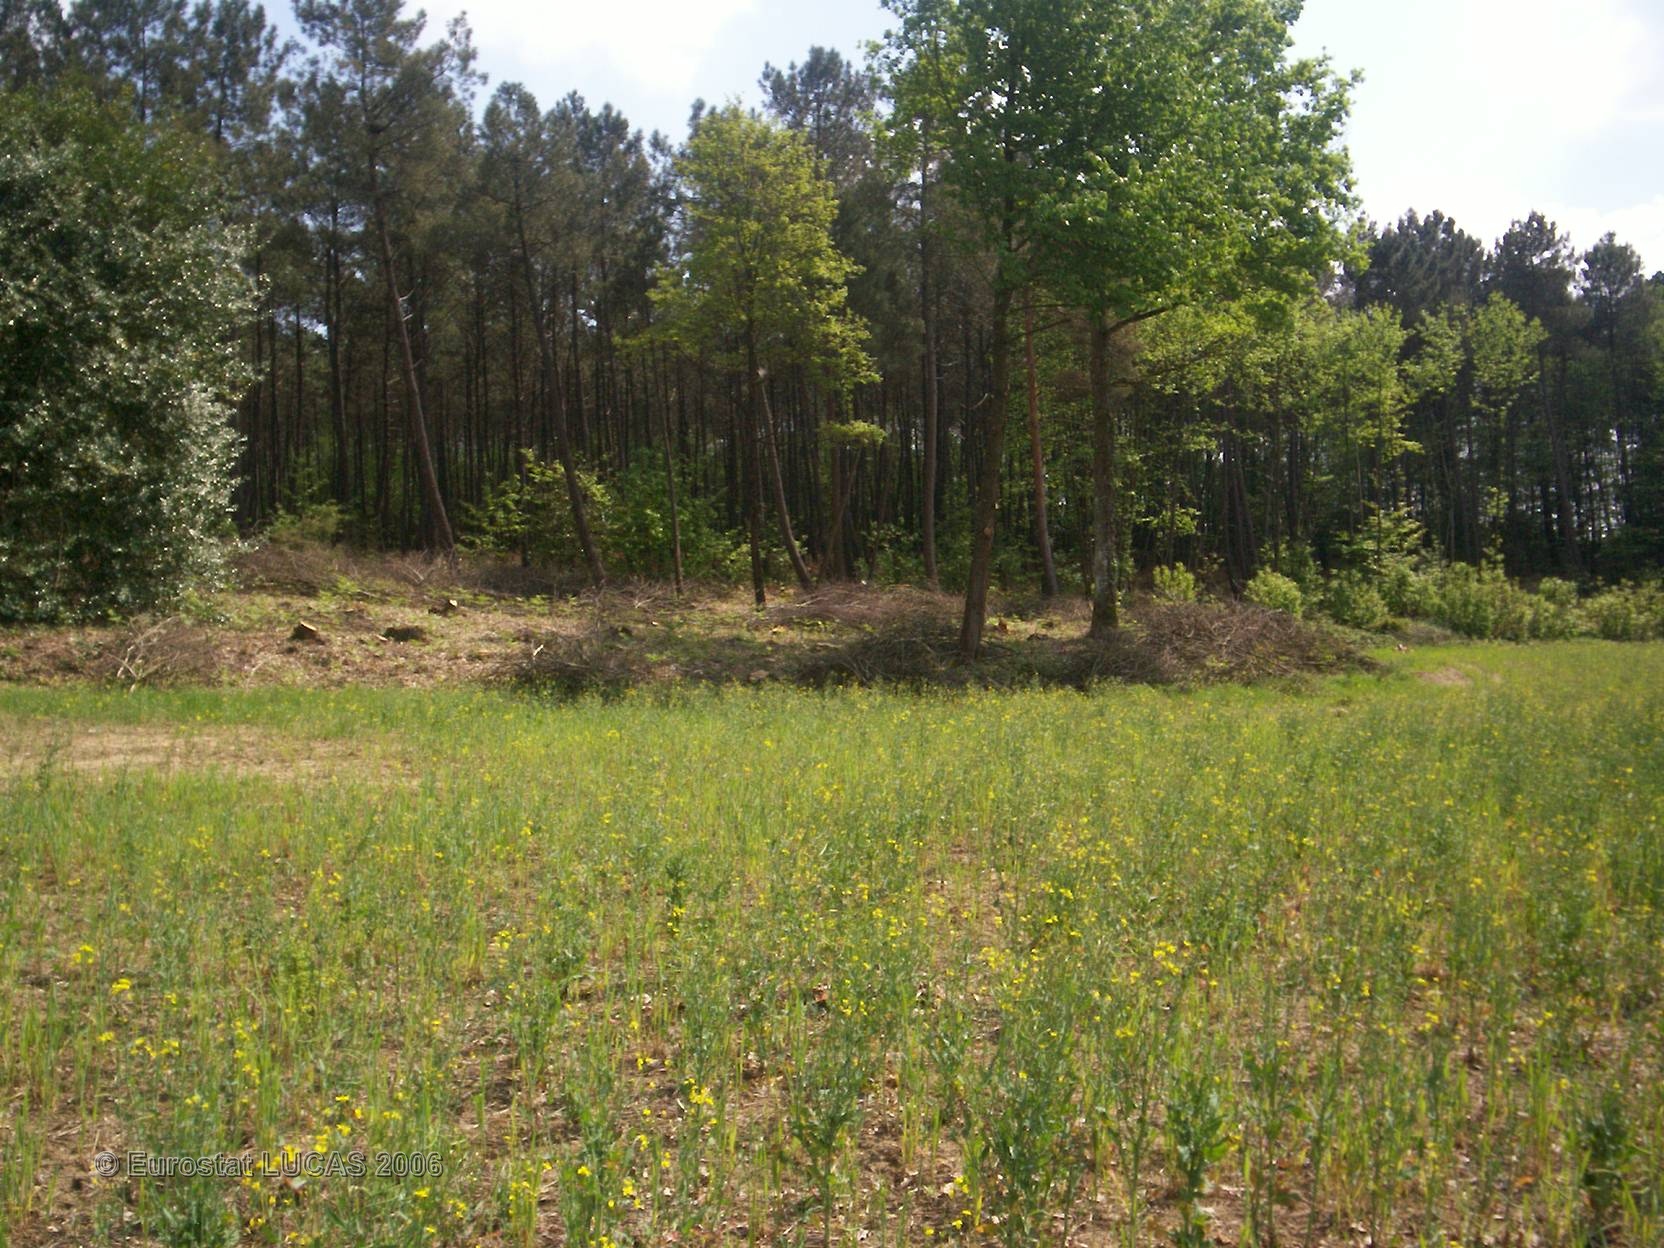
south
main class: Cropland
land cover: Rape and turnip rape
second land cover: Common wheat
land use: Agriculture (excluding fallow land and kitchen gardens)
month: May
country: FR
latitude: 47.6758
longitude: 0.1851
